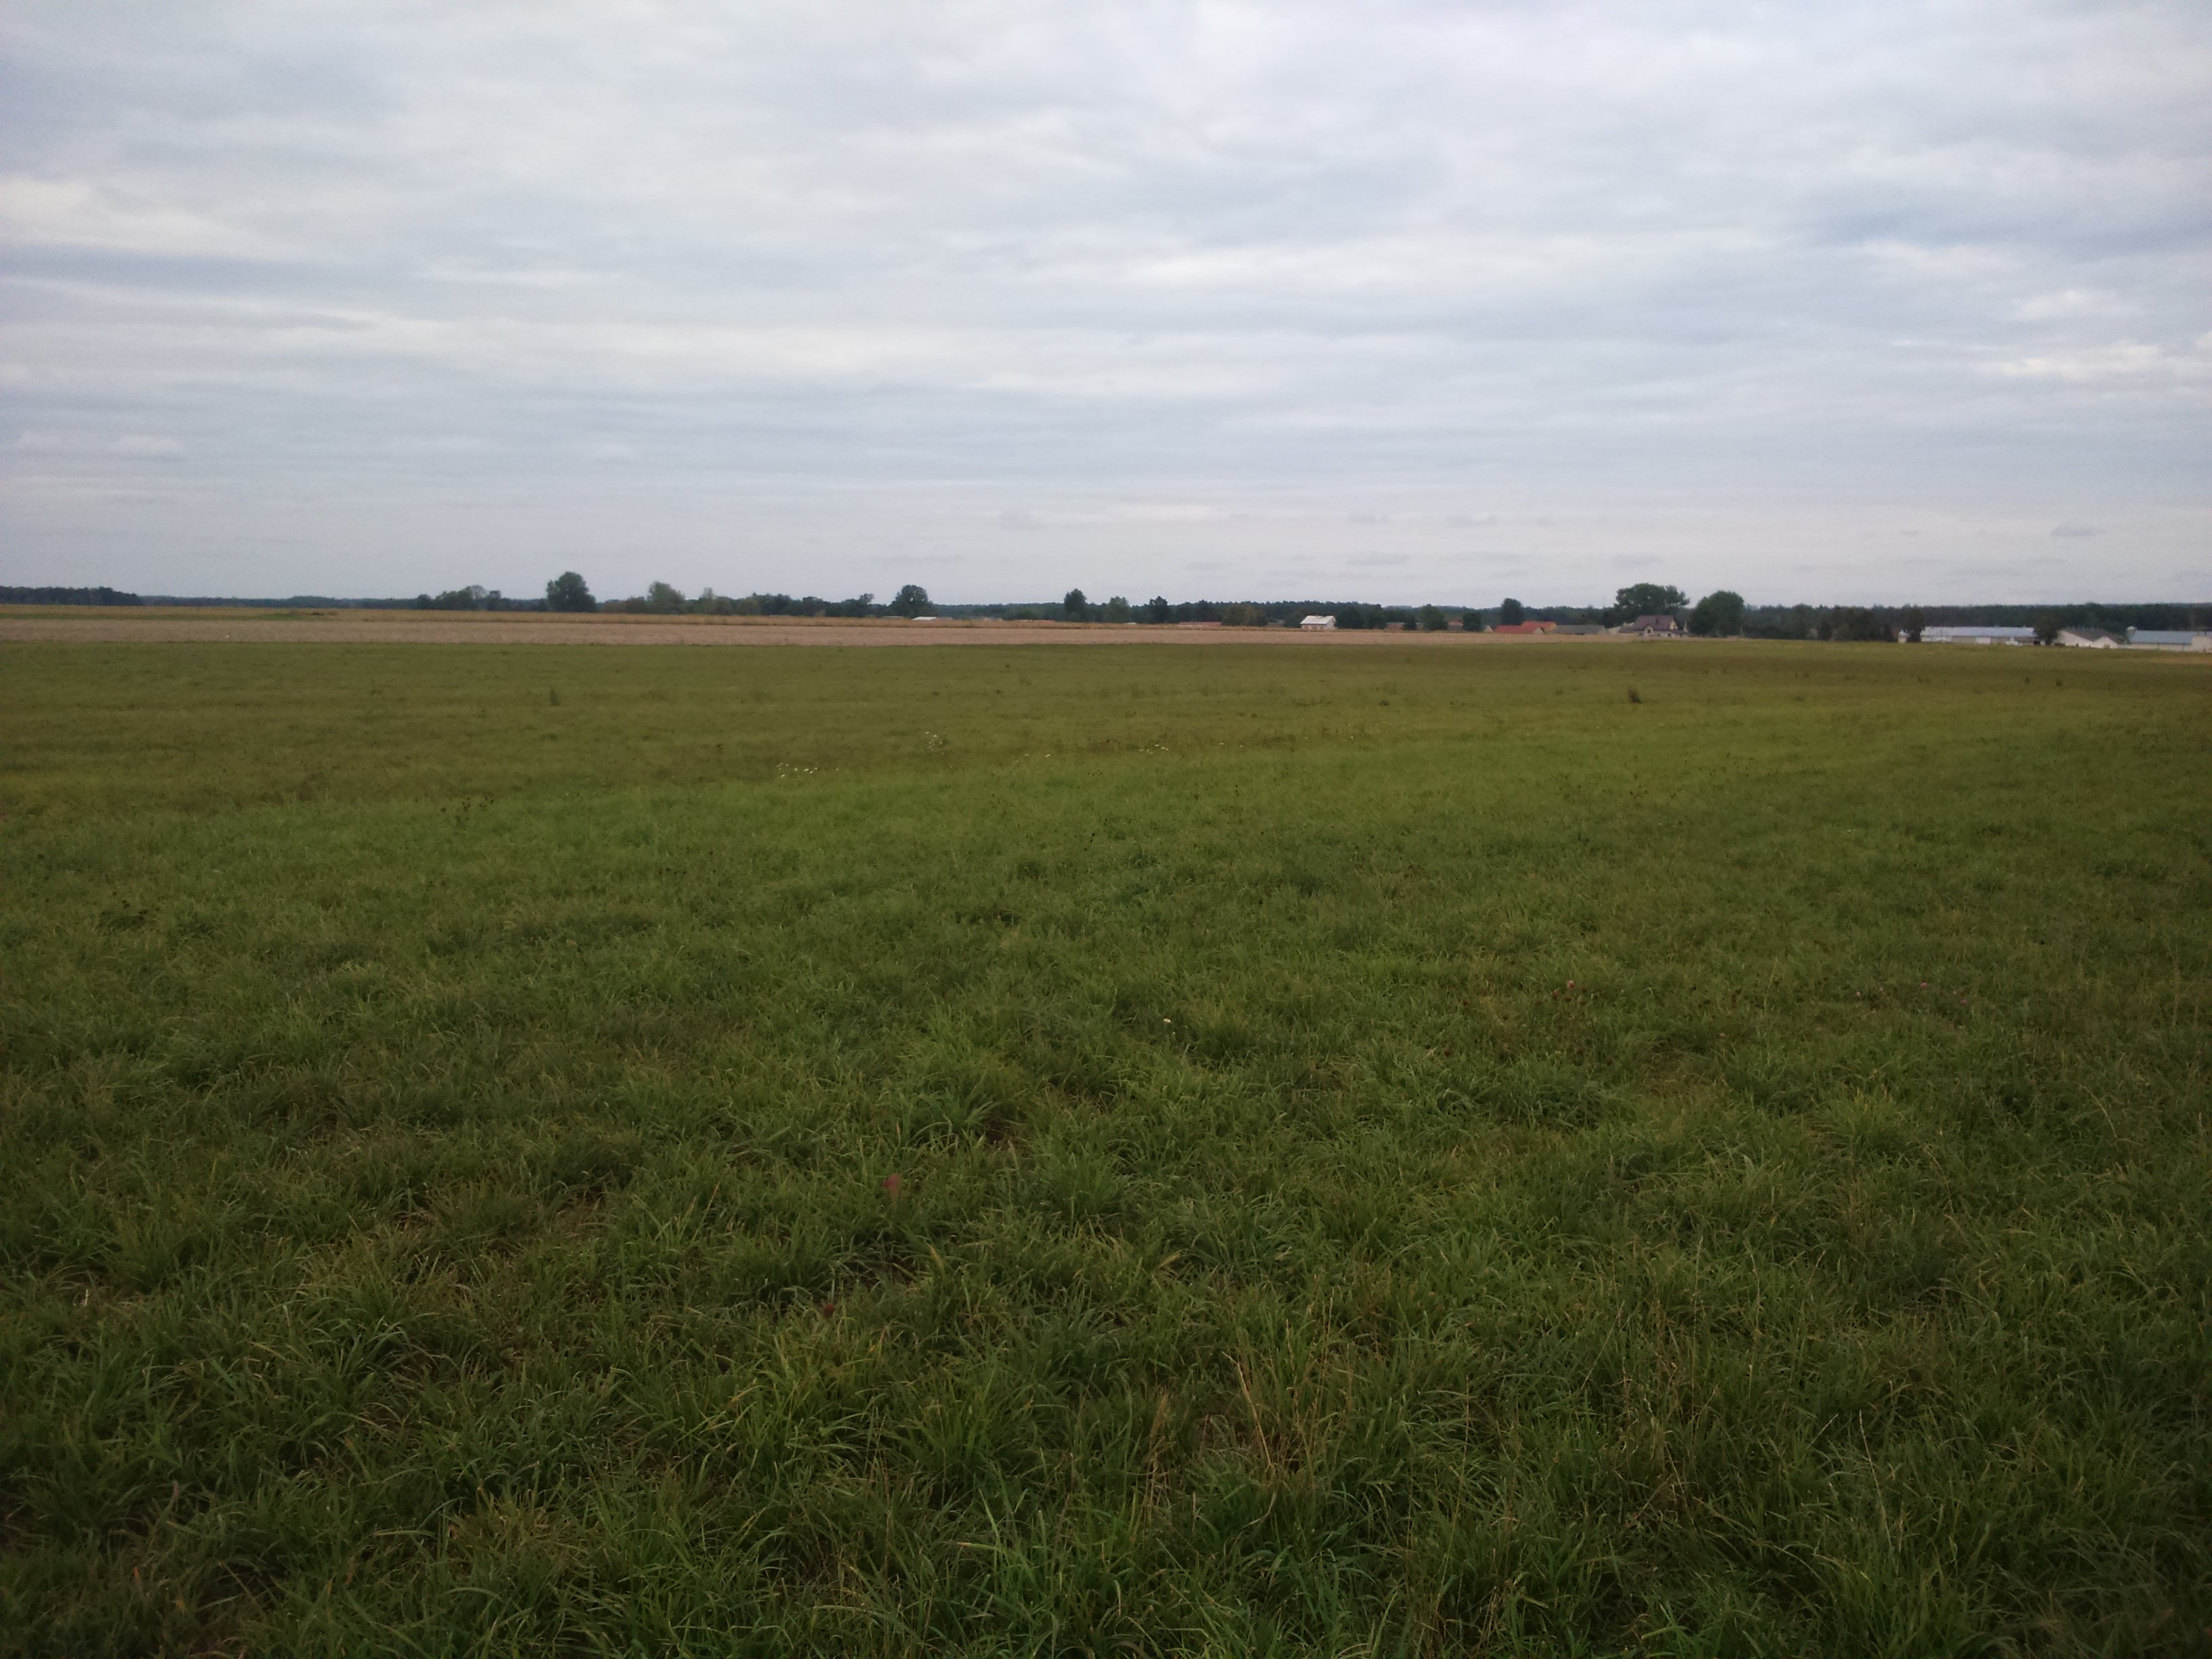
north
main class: Grassland
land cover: Grassland without tree/shrub cover
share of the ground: > 75 %
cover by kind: herbaceous plants 100 %
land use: Agriculture (excluding fallow land and kitchen gardens)
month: September
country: PL
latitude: 52.2690
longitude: 22.0609
